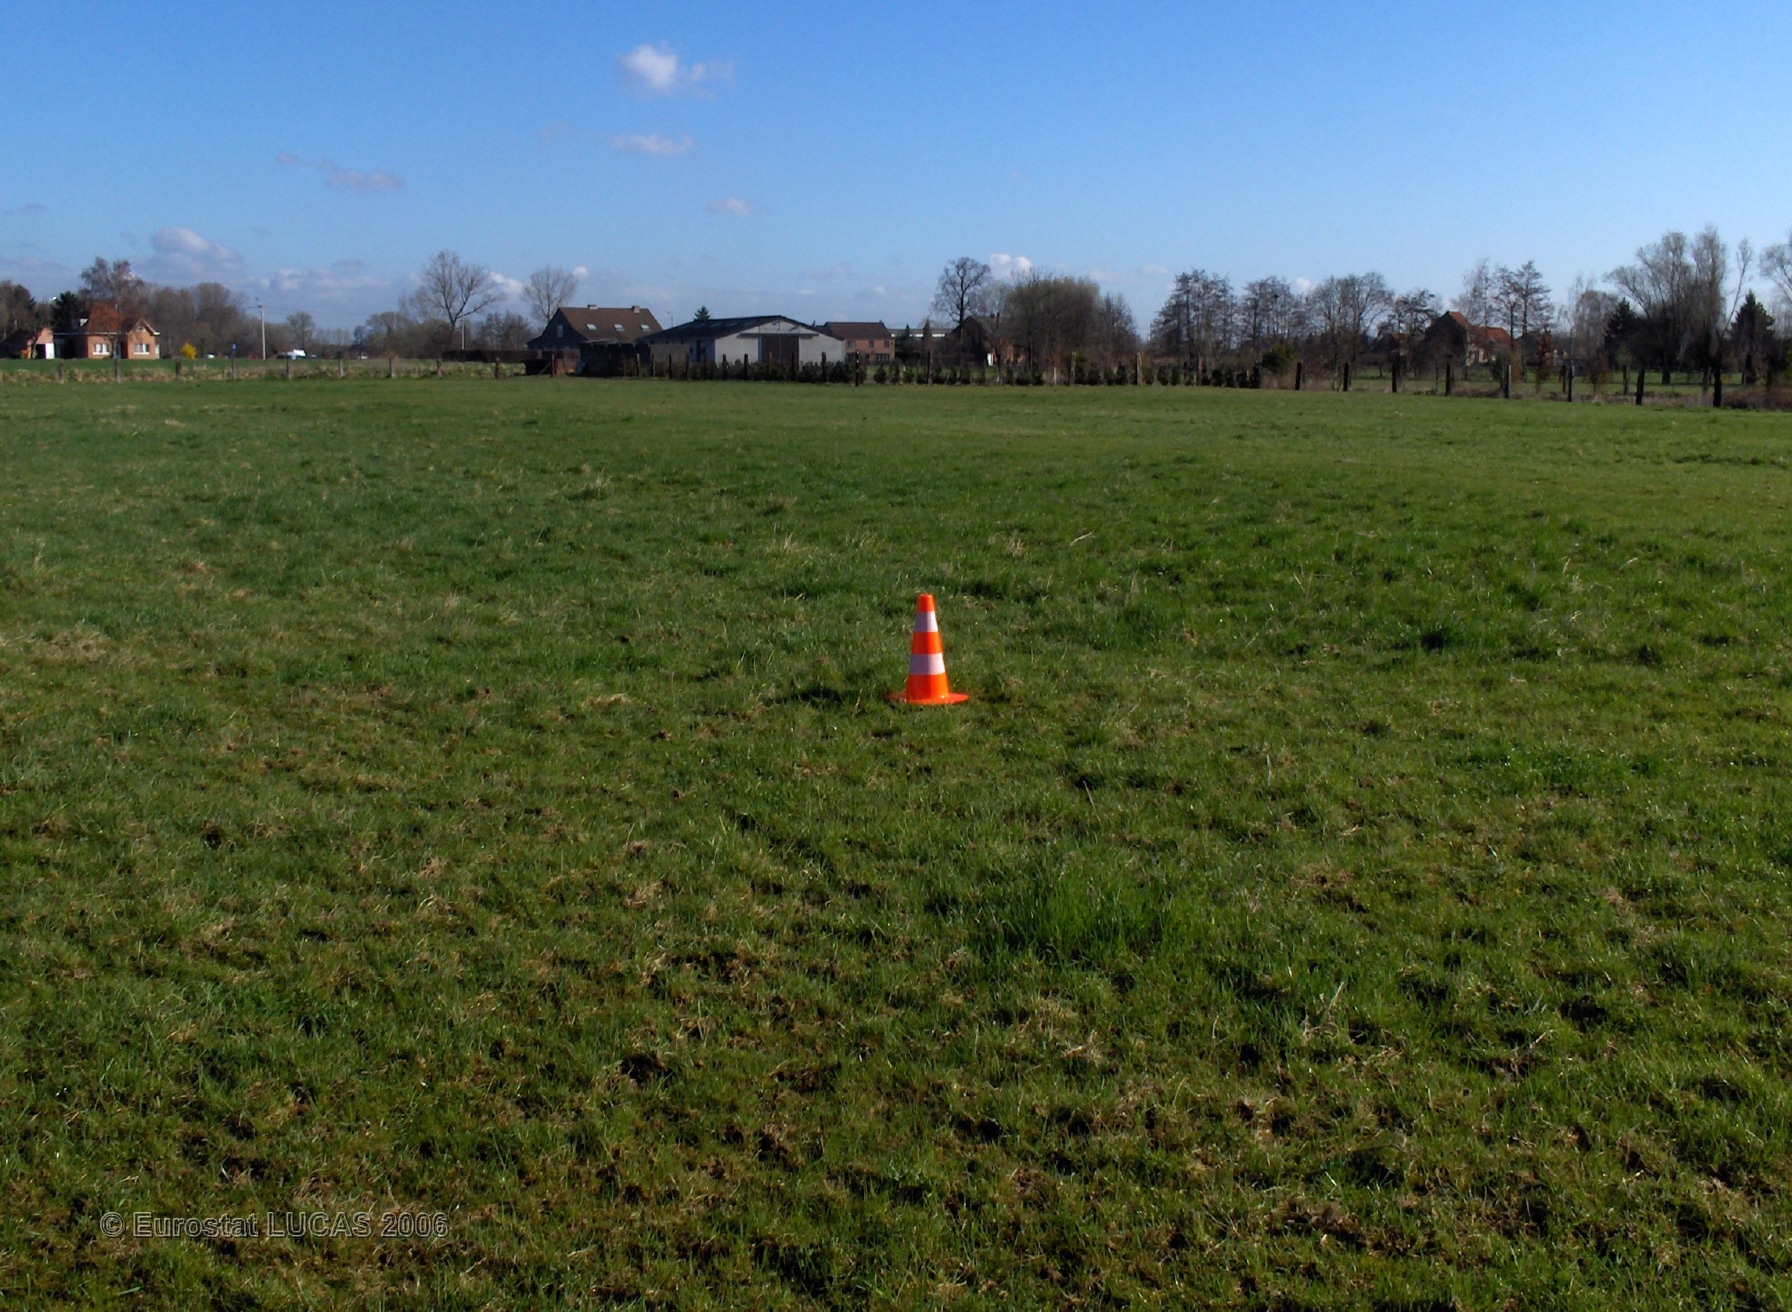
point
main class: Grassland
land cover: Grassland without tree/shrub cover
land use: Agriculture (excluding fallow land and kitchen gardens)
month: April
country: BE
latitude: 50.9851
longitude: 4.4257
